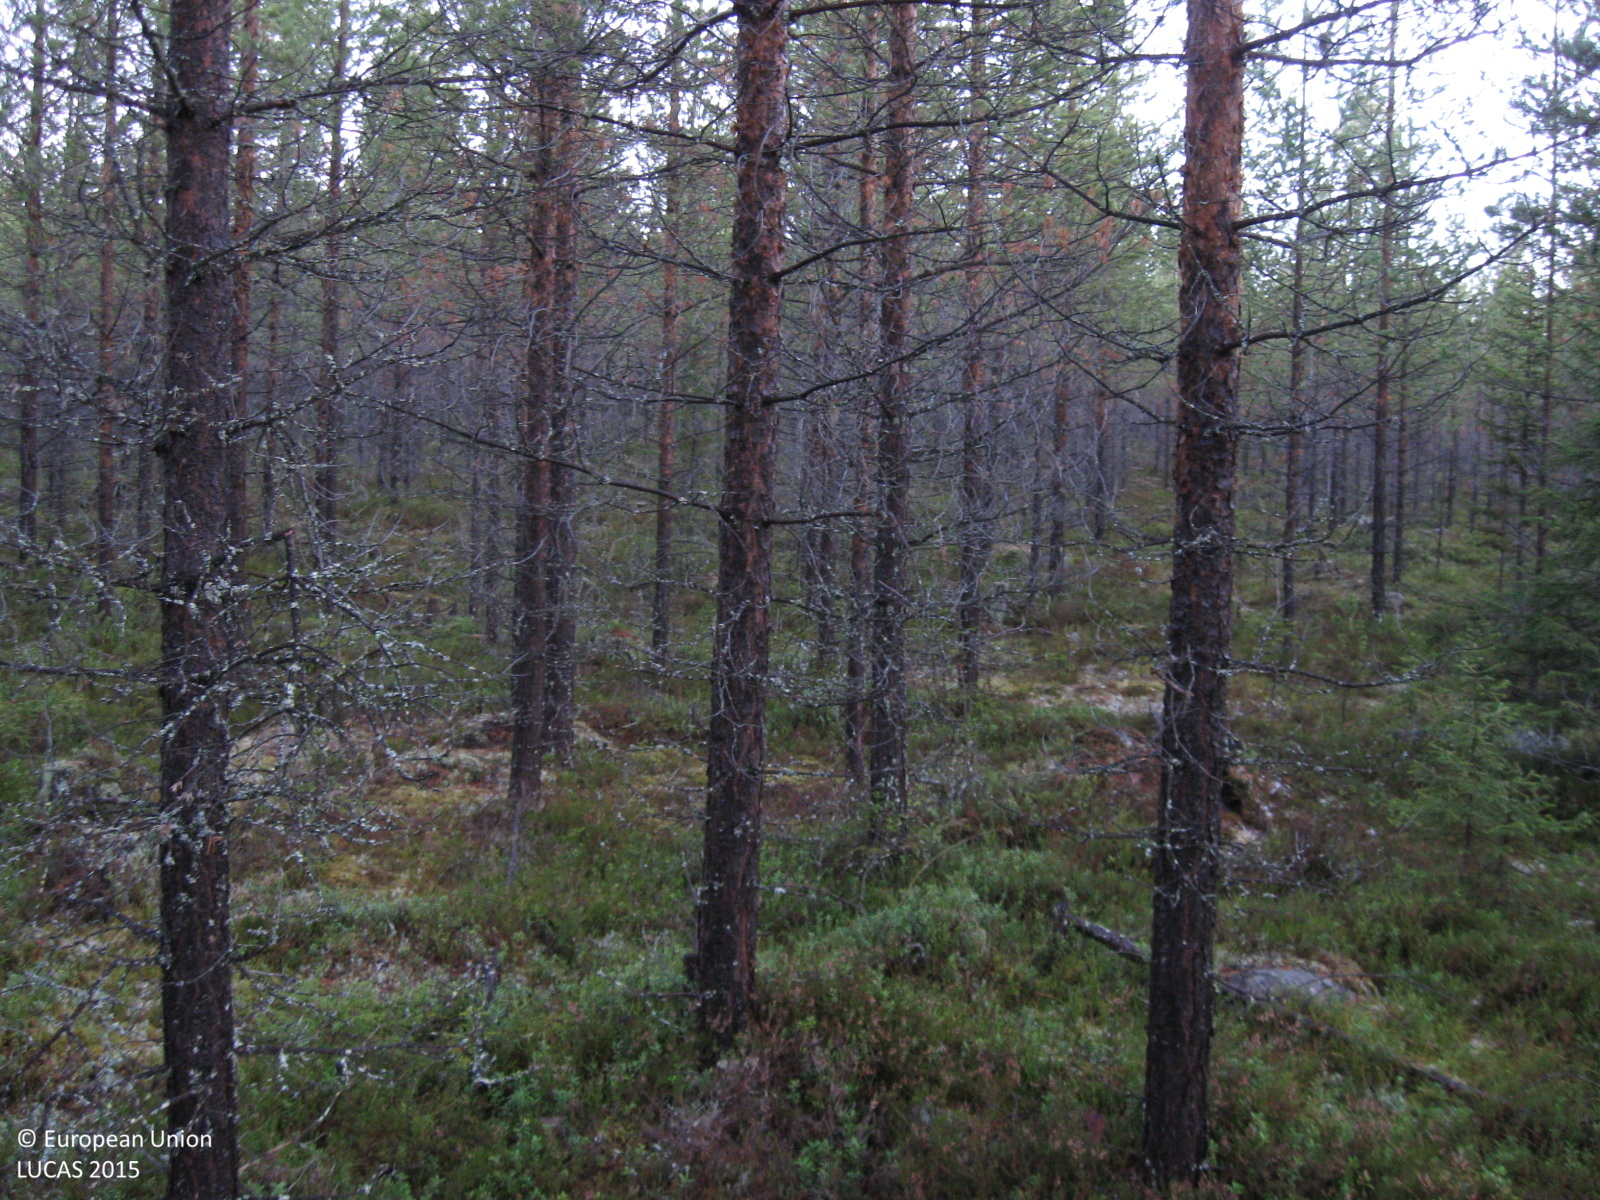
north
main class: Woodland
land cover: Pine dominated coniferous woodland
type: boreal forest
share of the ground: > 75 %
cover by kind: coniferous forest trees 80 %, shrubs 10 %, herbaceous plants 5 %, lichens and mosses 5 %
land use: Forestry
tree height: > 5 m
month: November
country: SE
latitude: 66.2259
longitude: 20.7422
